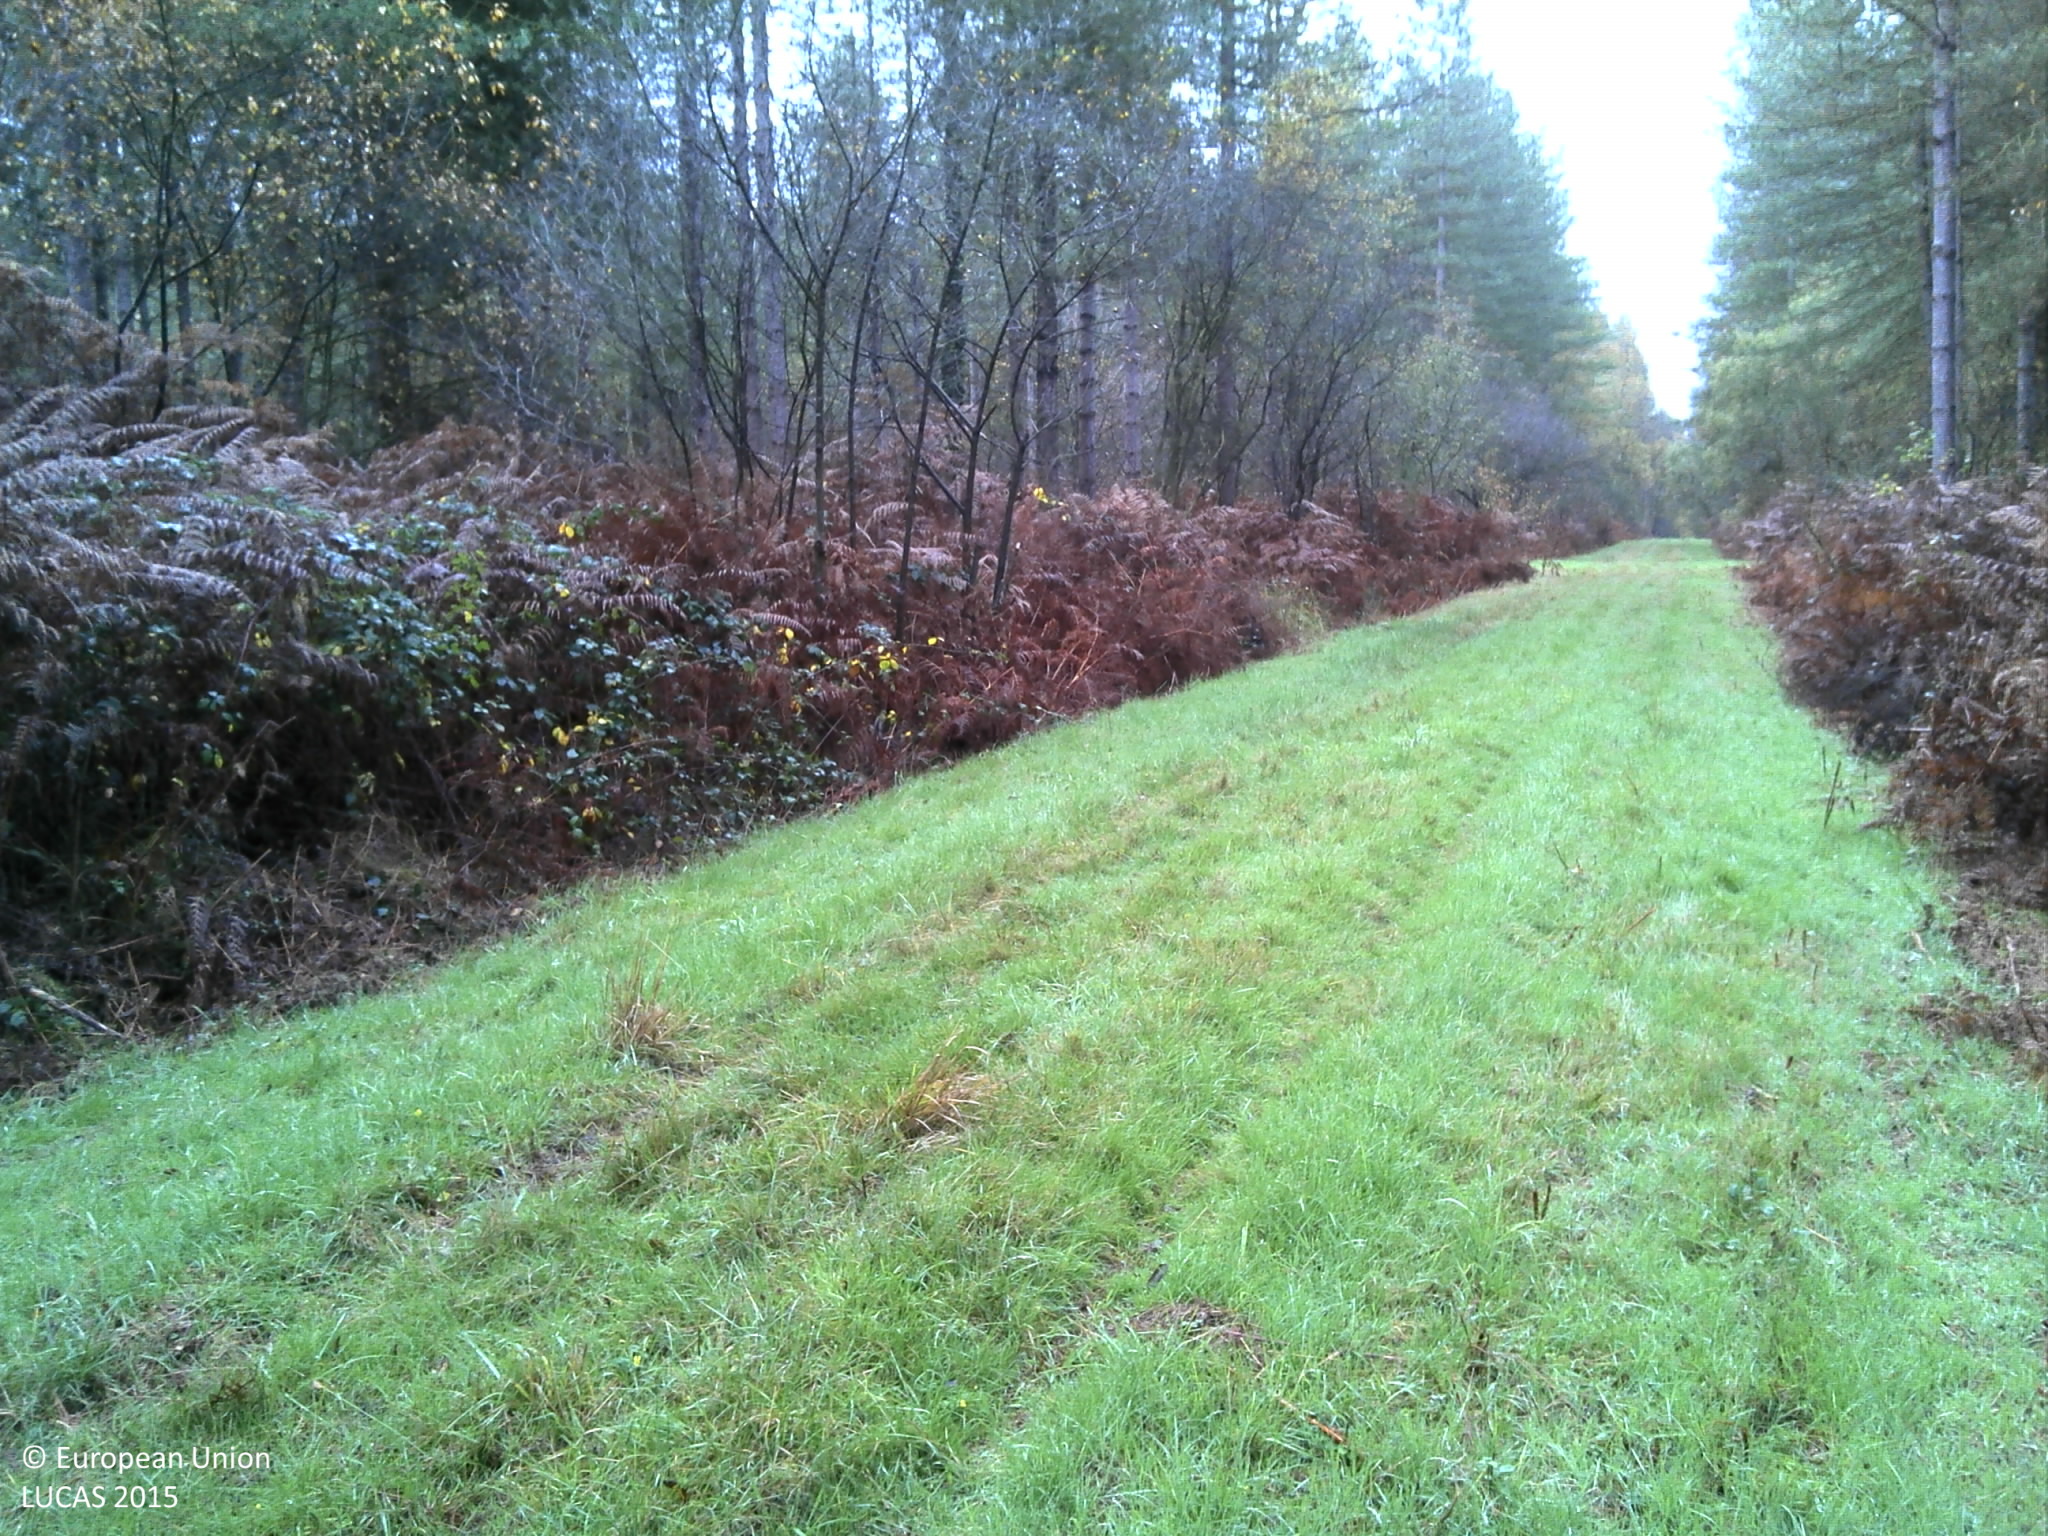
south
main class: Woodland
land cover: Pine dominated coniferous woodland
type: exotic forest
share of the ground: > 75 %
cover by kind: coniferous forest trees 85 %, herbaceous plants 15 %
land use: Forestry
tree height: > 5 m
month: November
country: FR
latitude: 47.6878
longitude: -1.5417
